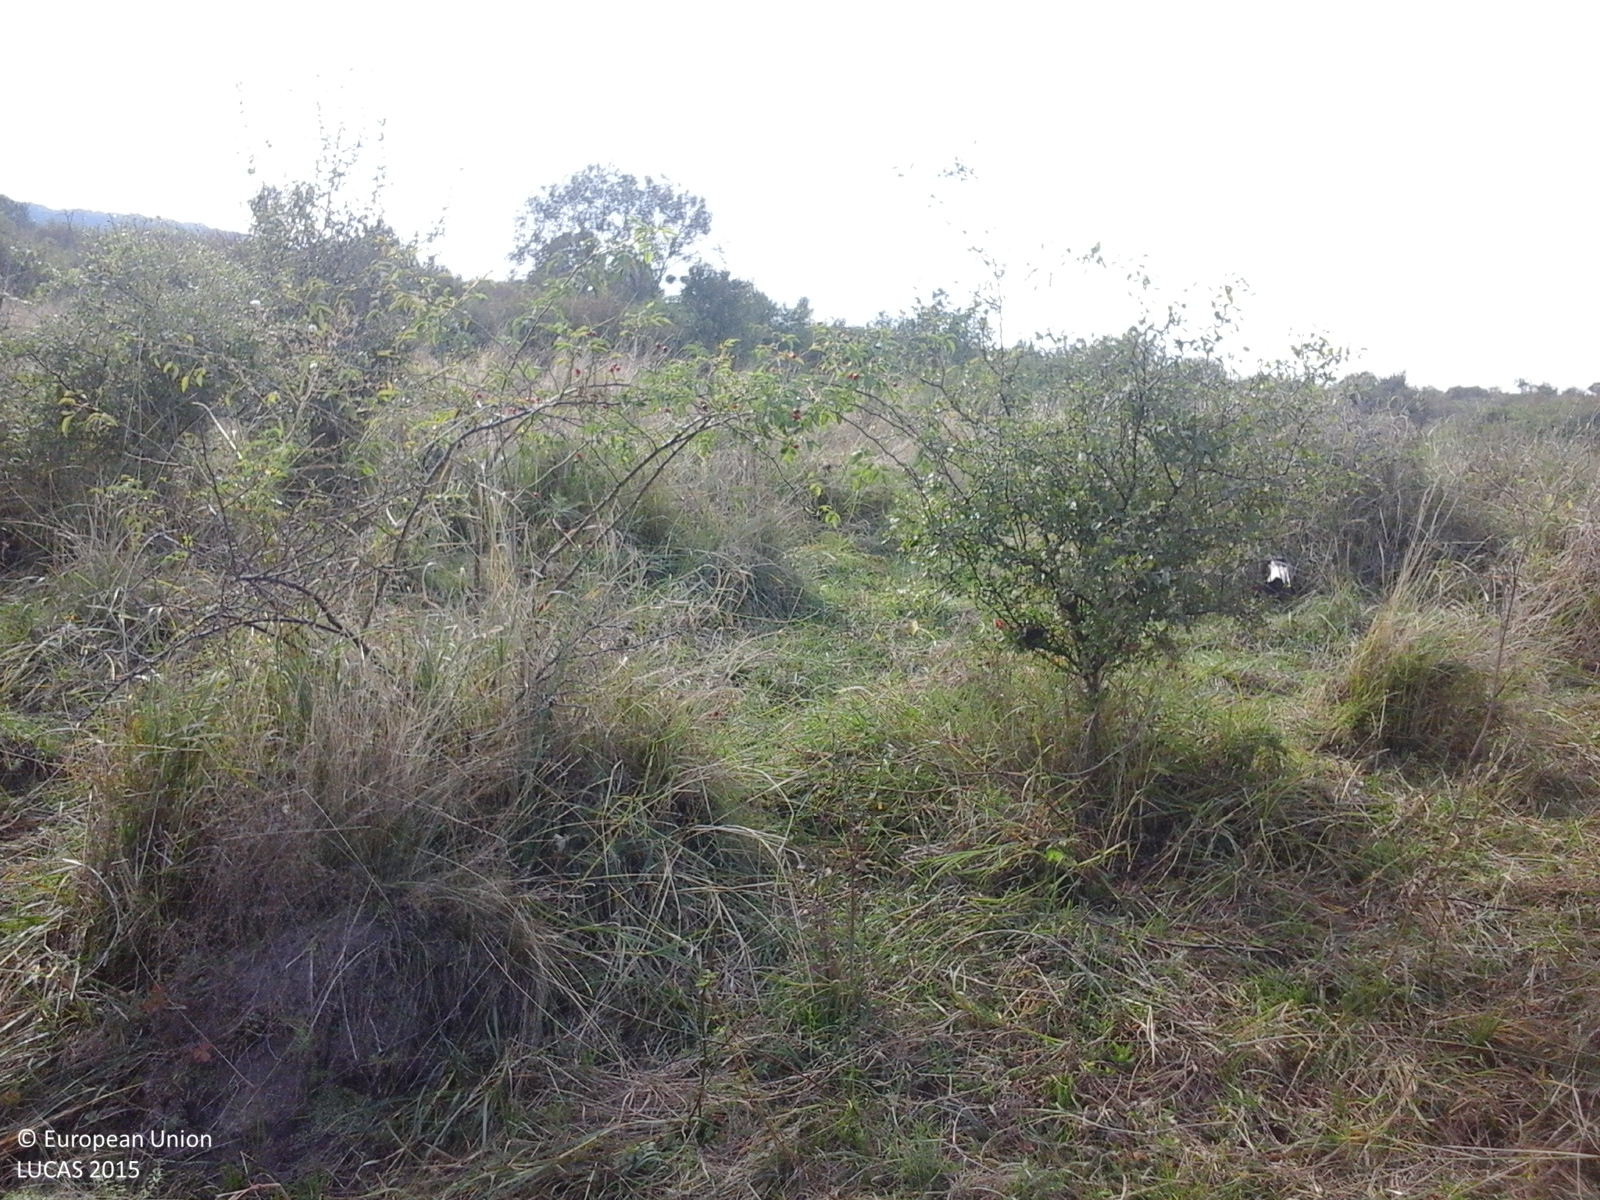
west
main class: Grassland
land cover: Grassland with sparse tree/shrub cover
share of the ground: > 75 %
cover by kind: herbaceous plants 85 %, shrubs 10 %, broadleaved forest trees 5 %
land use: Agriculture (excluding fallow land and kitchen gardens)
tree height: < 5 m
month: September
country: RO
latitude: 47.1125
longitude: 23.6618
